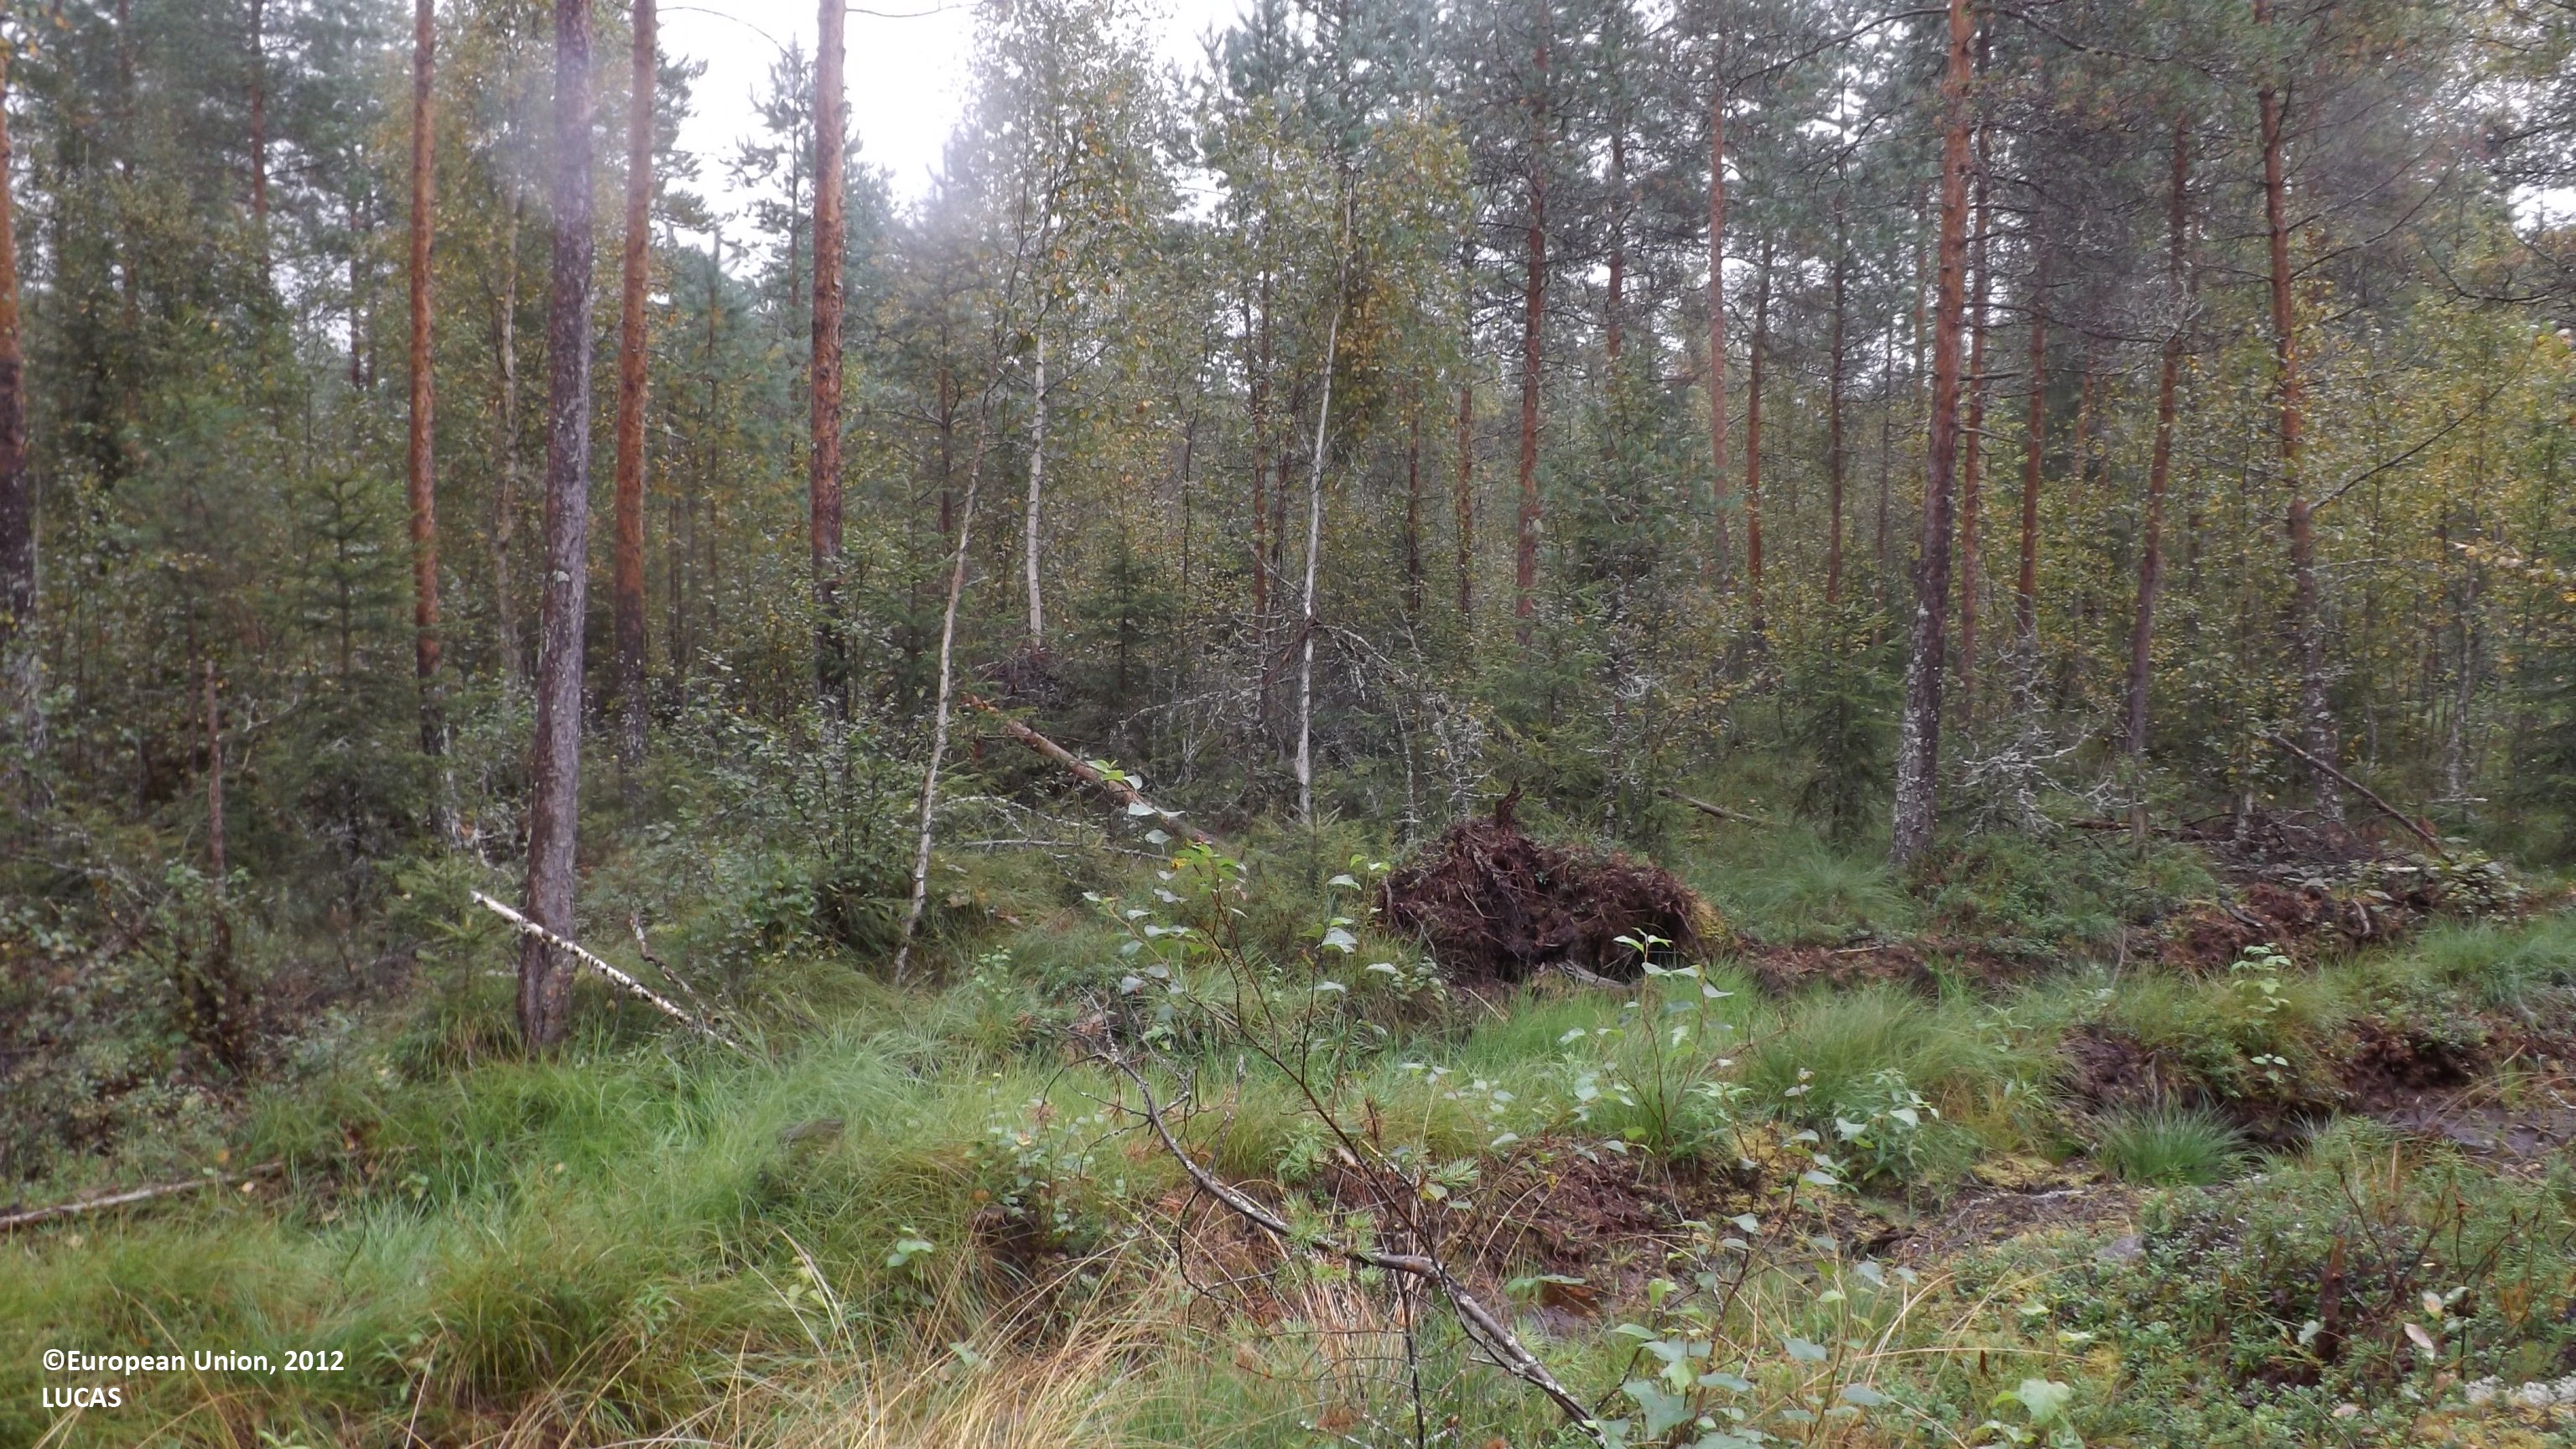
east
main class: Woodland
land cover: Pine dominated mixed woodland
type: boreal forest
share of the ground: 25 - 50 %
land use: Forestry
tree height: > 5 m
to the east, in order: Pine dominated mixed woodland; Tracks; Ditches and canals; Pine dominated mixed woodland; Ditches and canals; Pine dominated mixed woodland; Ditches and canals; Pine dominated mixed woodland
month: August
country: FI
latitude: 63.7912
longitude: 23.5971
